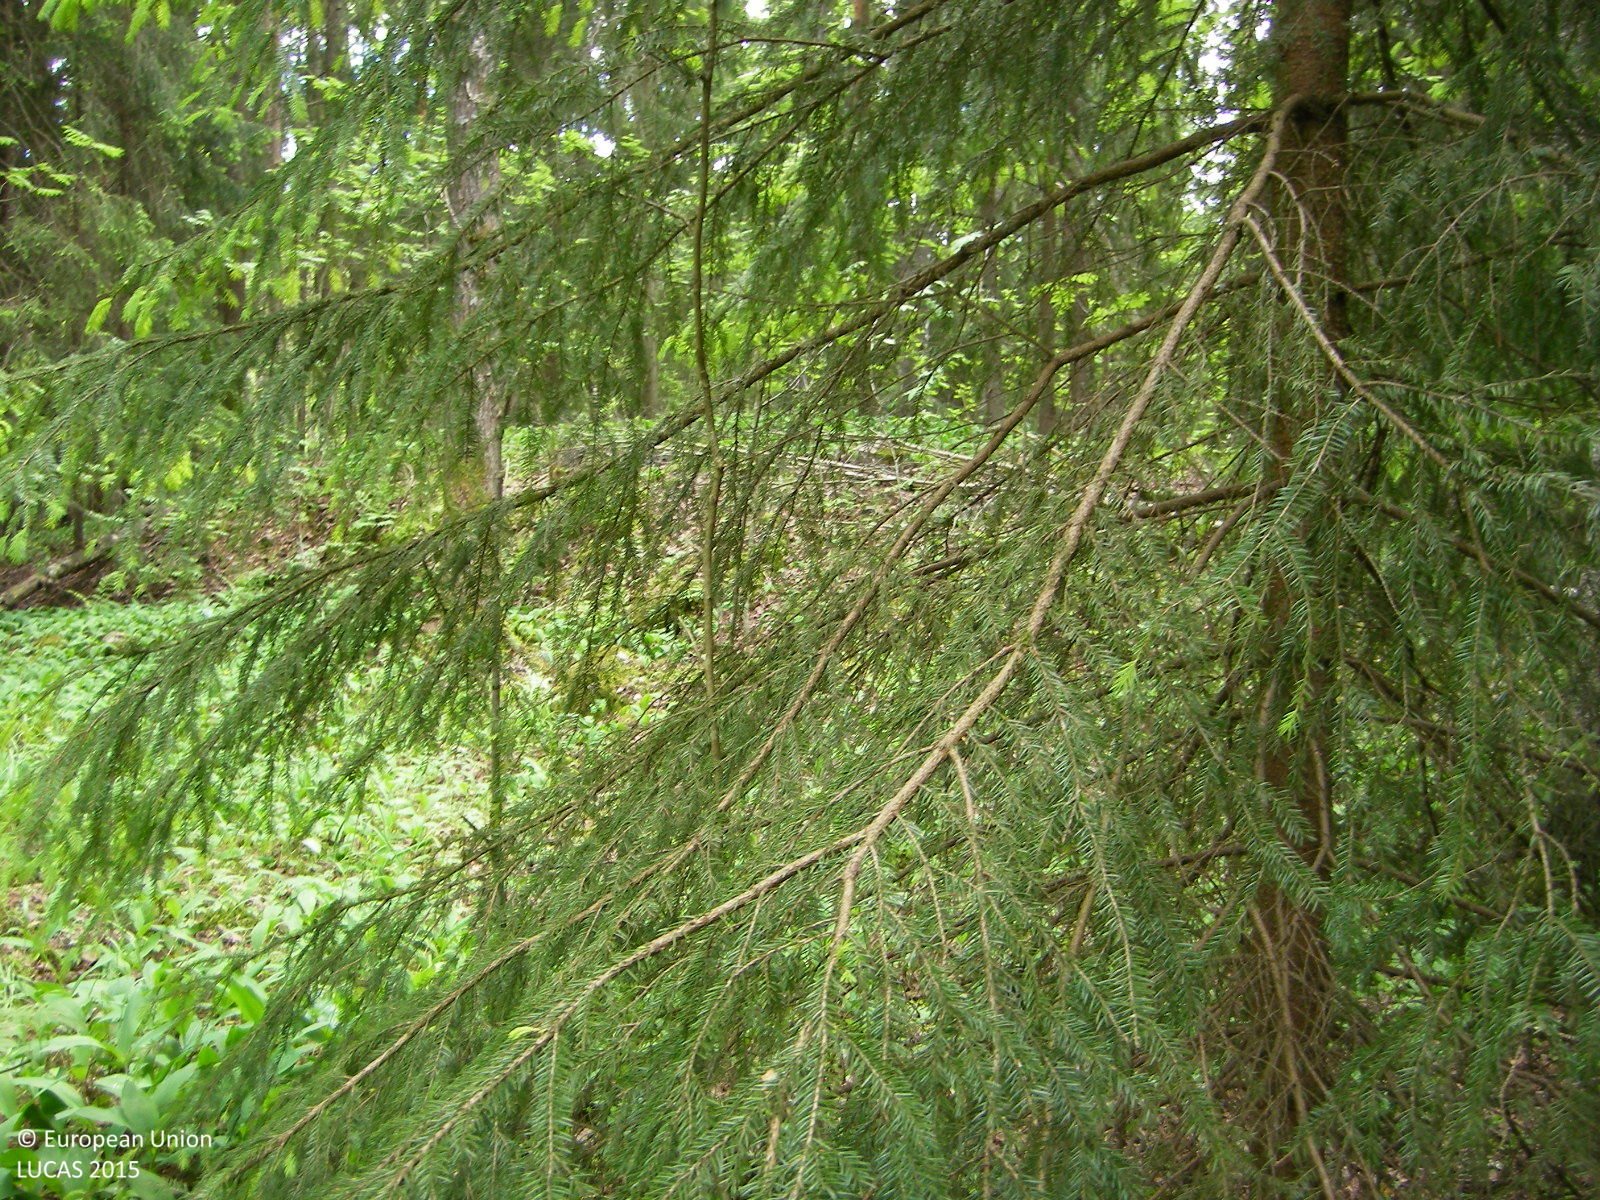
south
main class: Woodland
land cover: Spruce dominated mixed woodland
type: boreal forest
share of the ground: > 75 %
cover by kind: broadleaved forest trees 50 %, coniferous forest trees 40 %, herbaceous plants 10 %
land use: Semi-natural and natural areas not in use
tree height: > 5 m
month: June
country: FI
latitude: 60.1935
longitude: 24.7037
